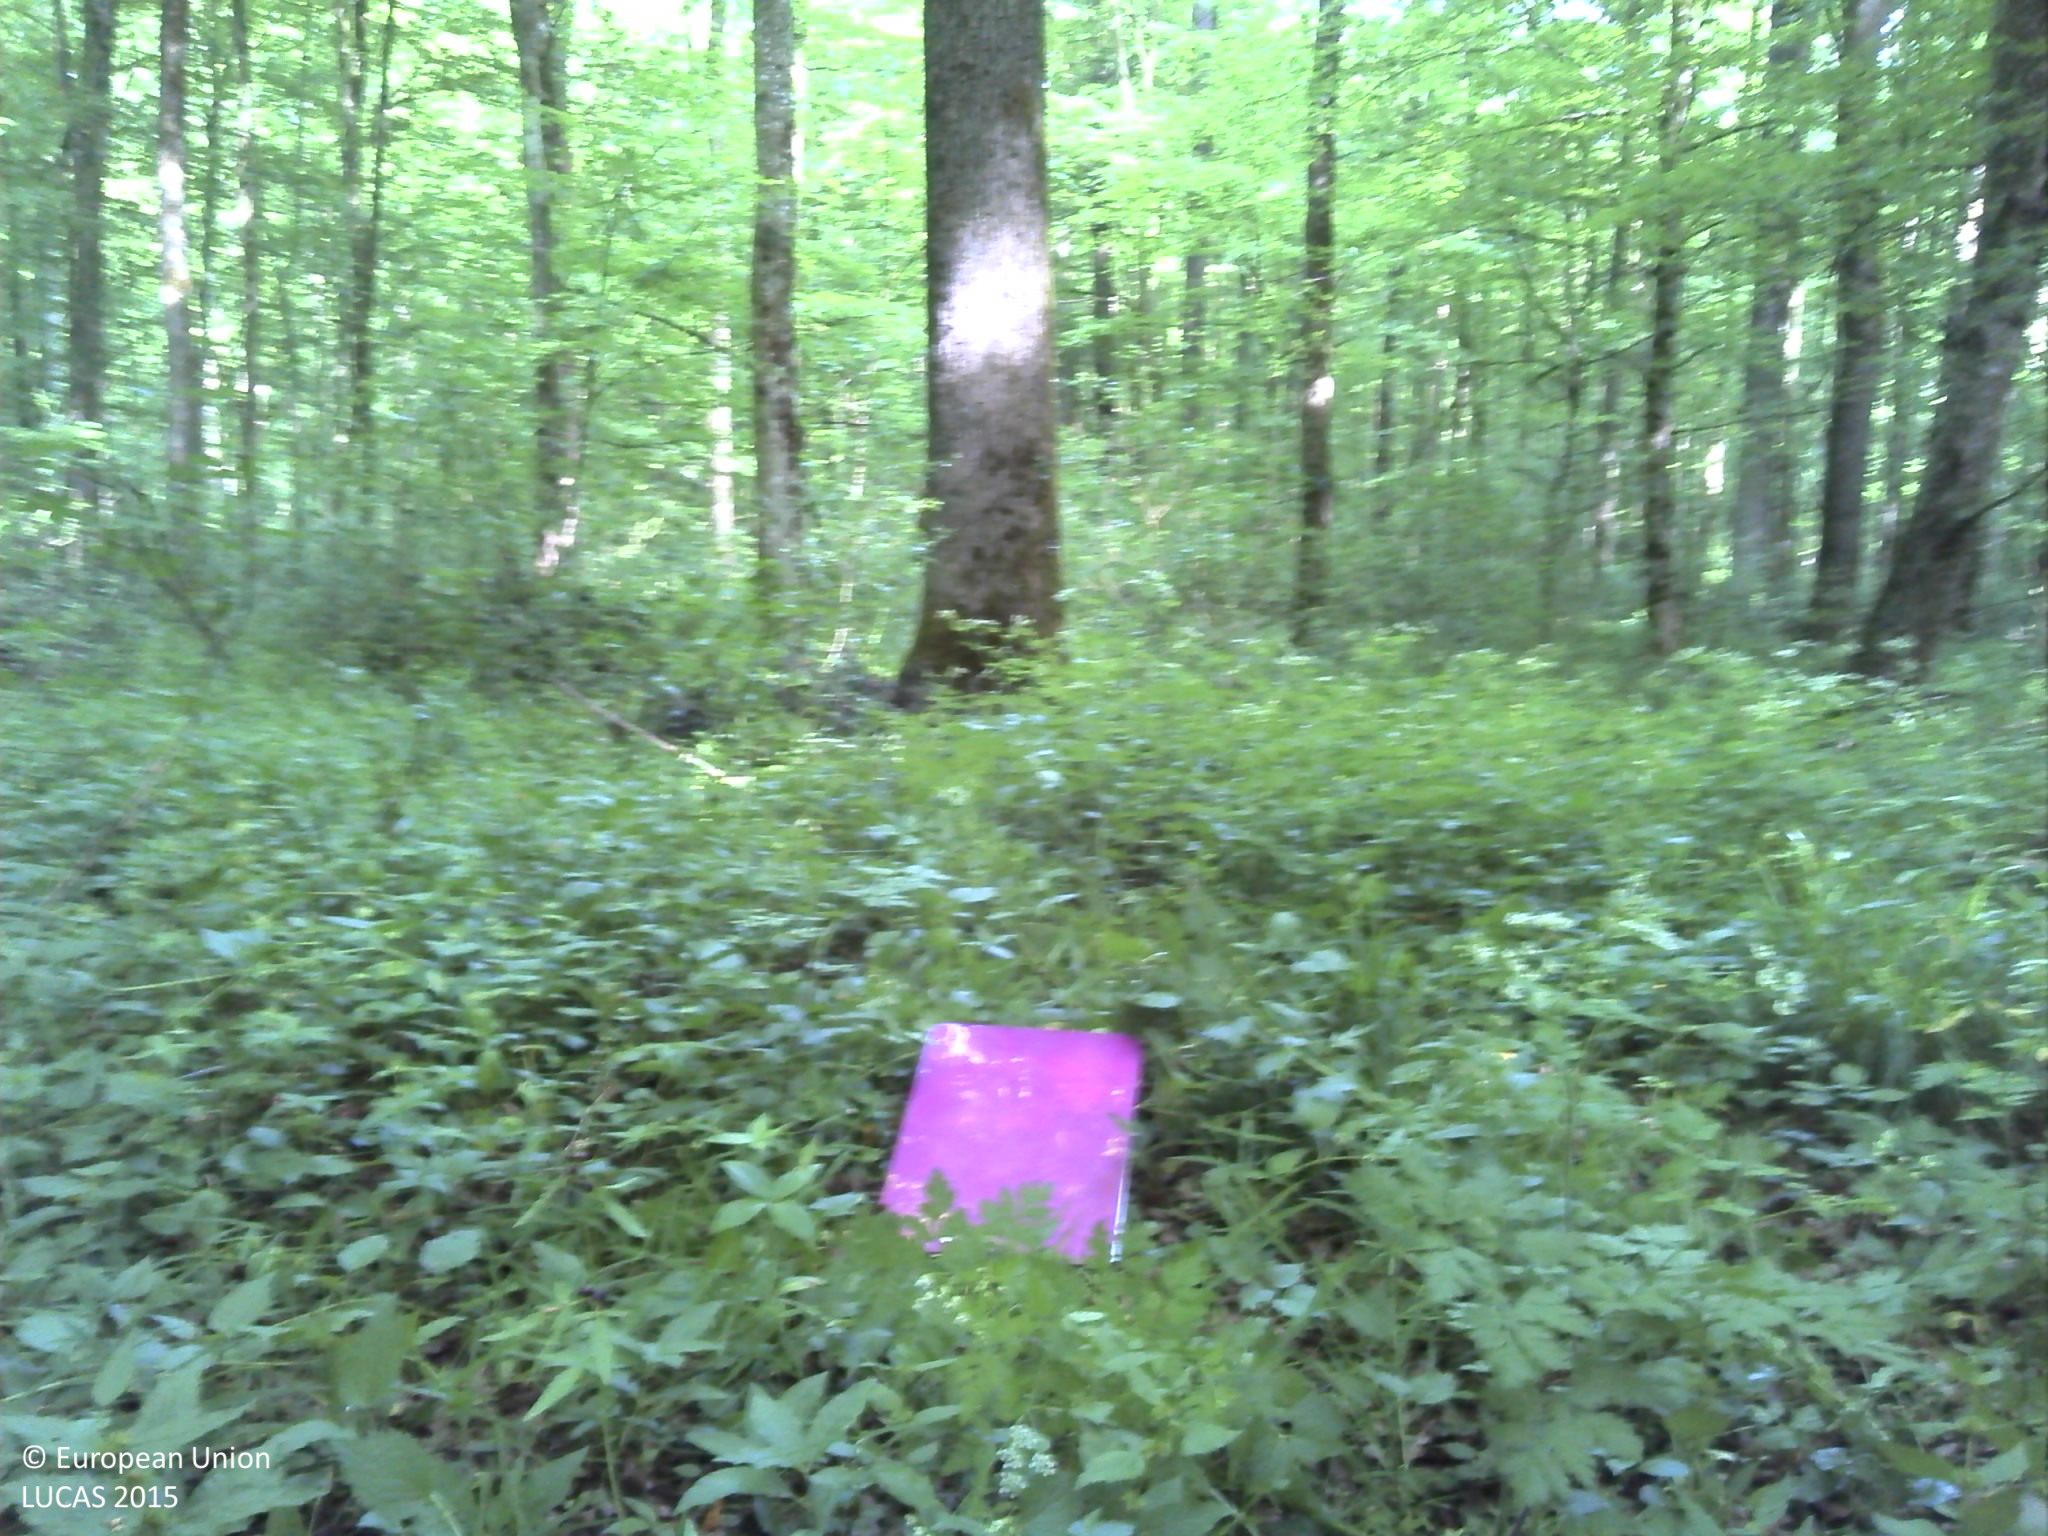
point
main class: Woodland
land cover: Broadleaved woodland
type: acidophilous oak and oak-birch forest
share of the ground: > 75 %
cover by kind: broadleaved forest trees 100 %
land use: Forestry
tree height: > 5 m
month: May
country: HR
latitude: 45.6156
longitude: 18.2512
